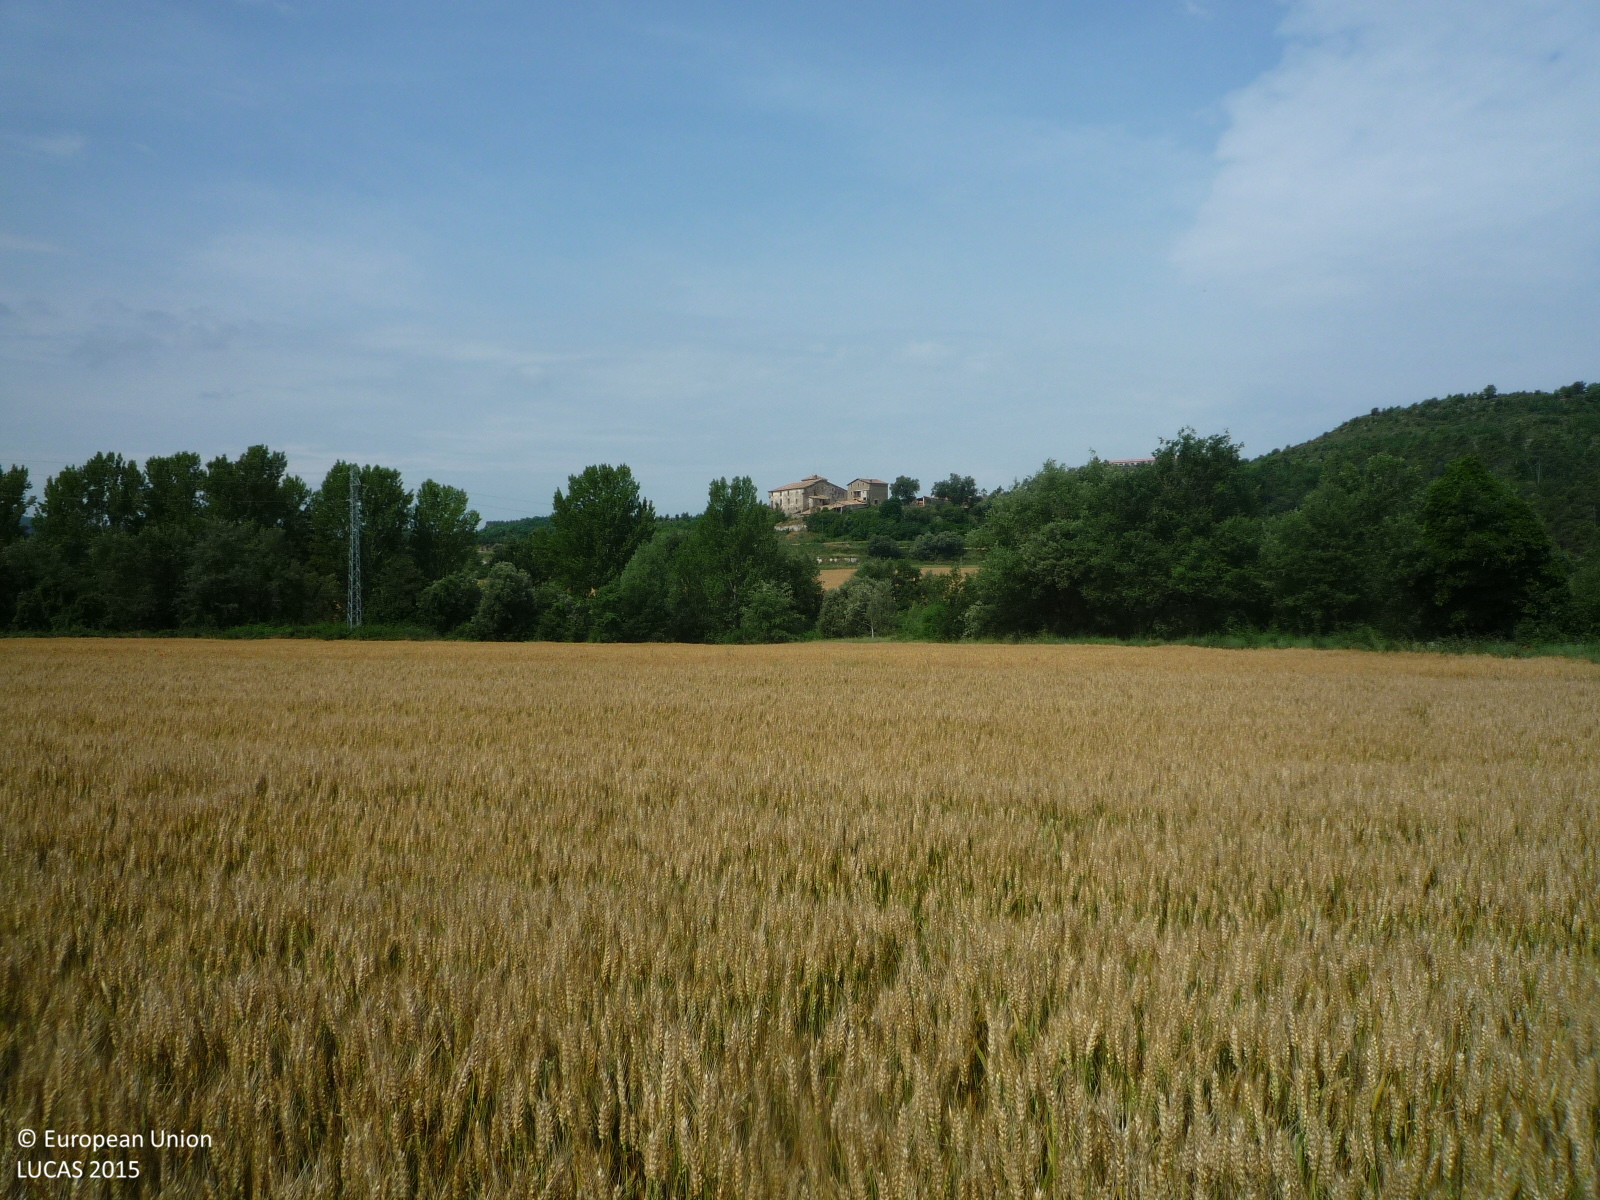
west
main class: Cropland
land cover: Durum wheat
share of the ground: > 75 %
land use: Agriculture (excluding fallow land and kitchen gardens)
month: June
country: ES
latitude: 42.0094
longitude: 1.9842
